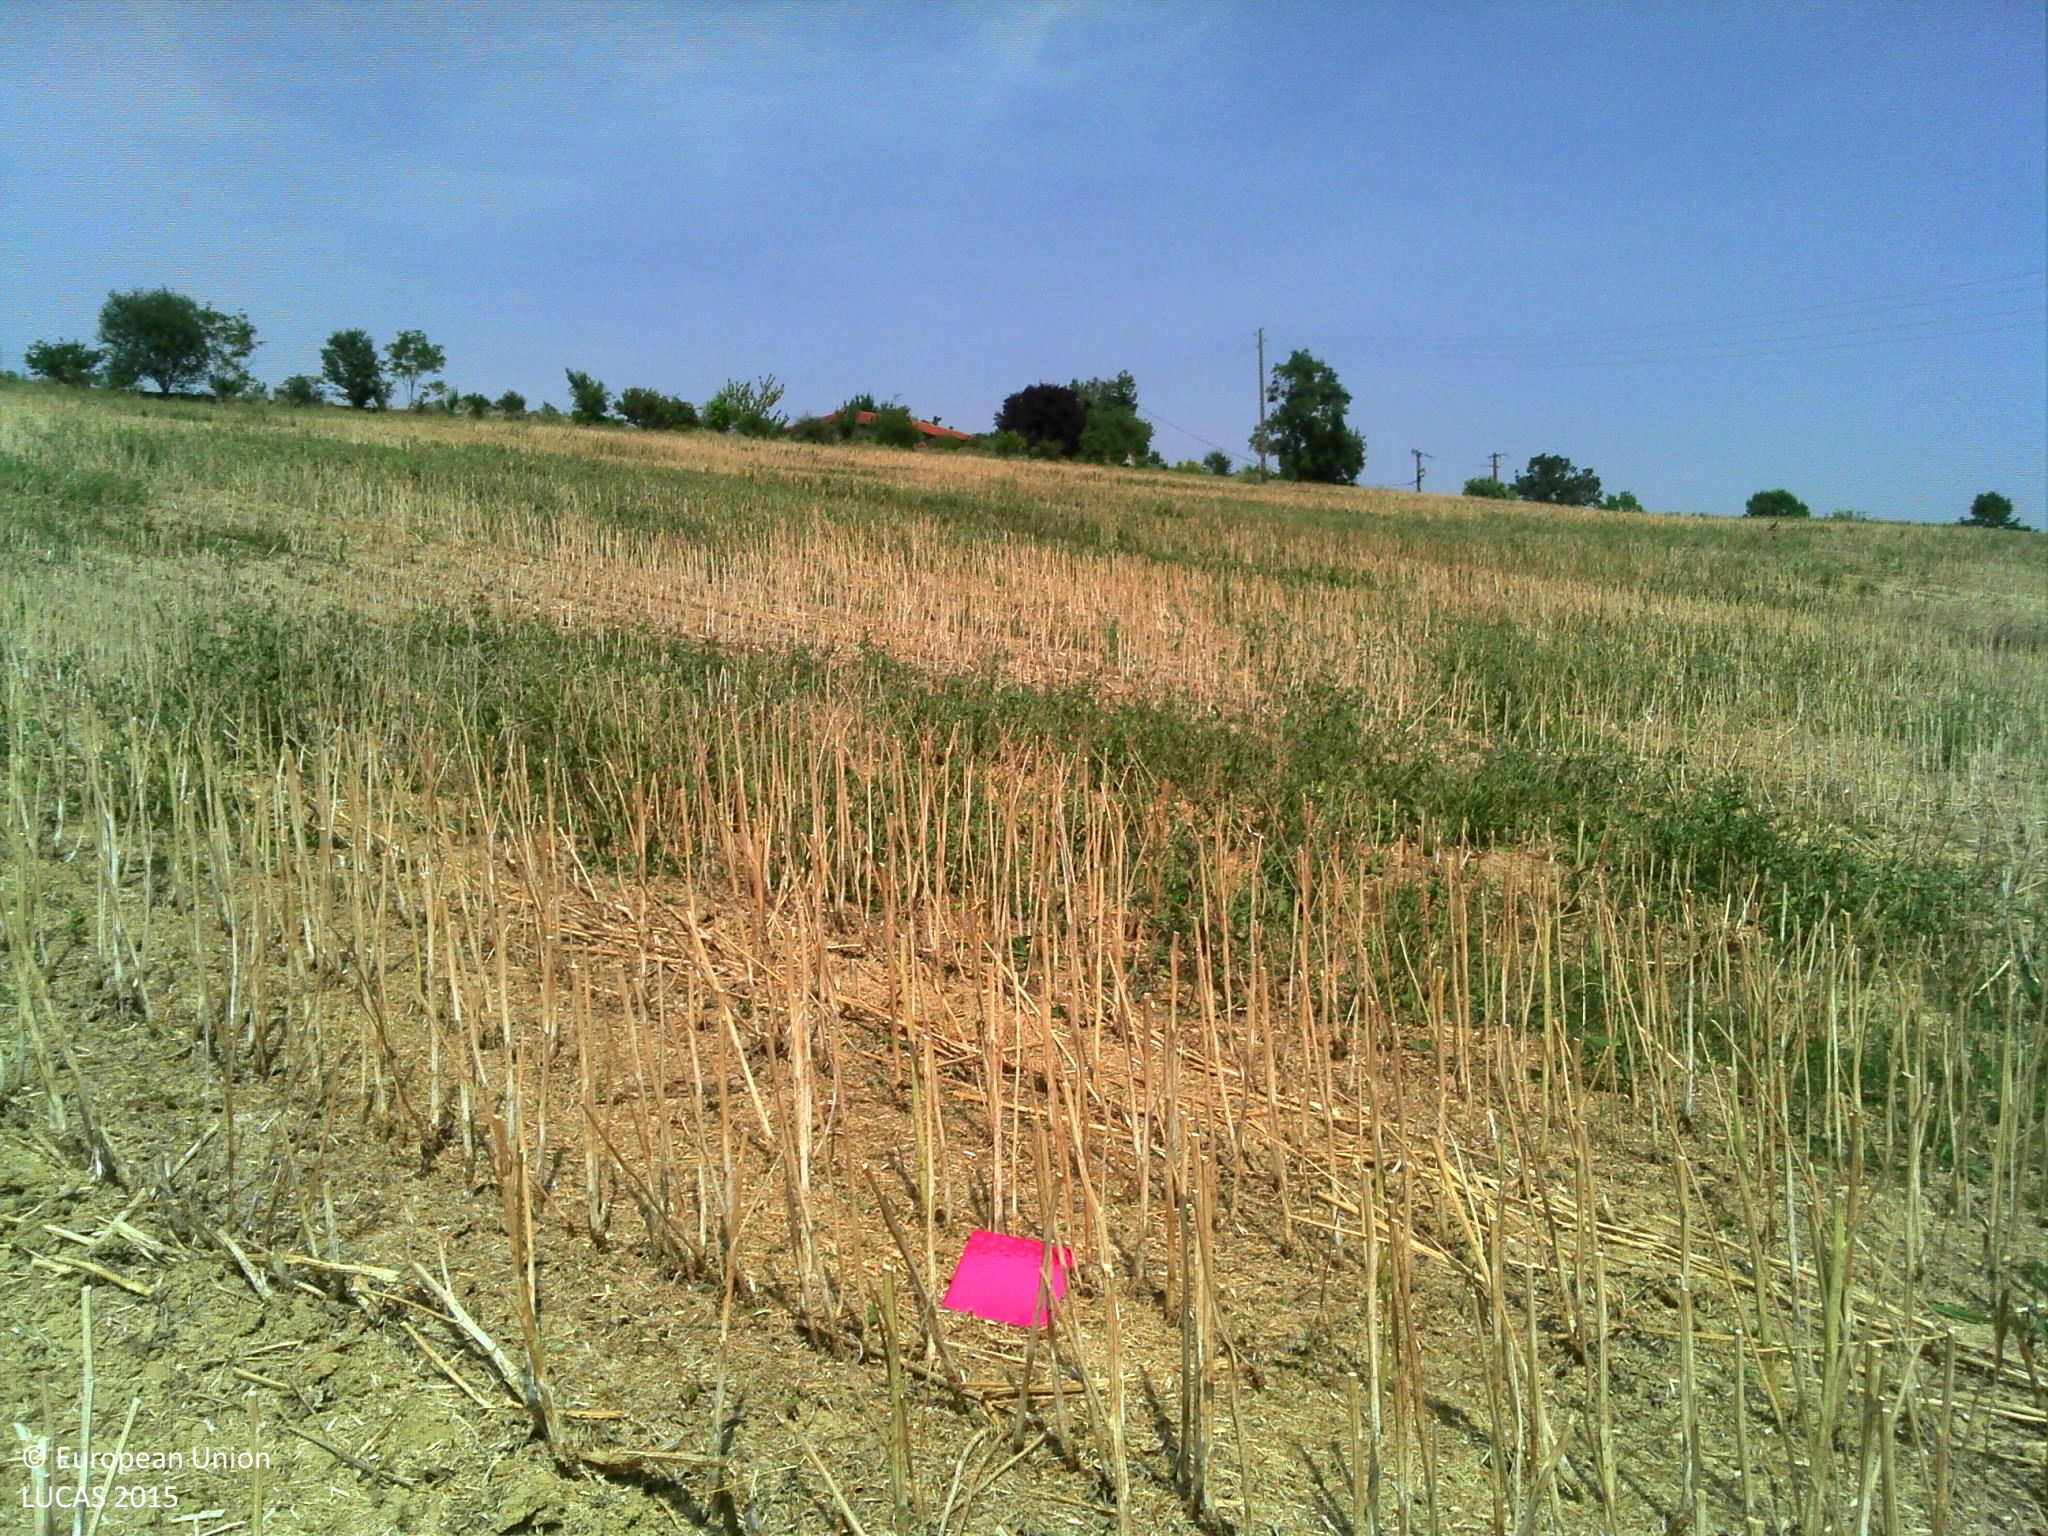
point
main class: Cropland
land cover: Rape and turnip rape
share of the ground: 10 - 25 %
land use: Agriculture (excluding fallow land and kitchen gardens)
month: July
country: FR
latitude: 43.6449
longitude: 0.9374
